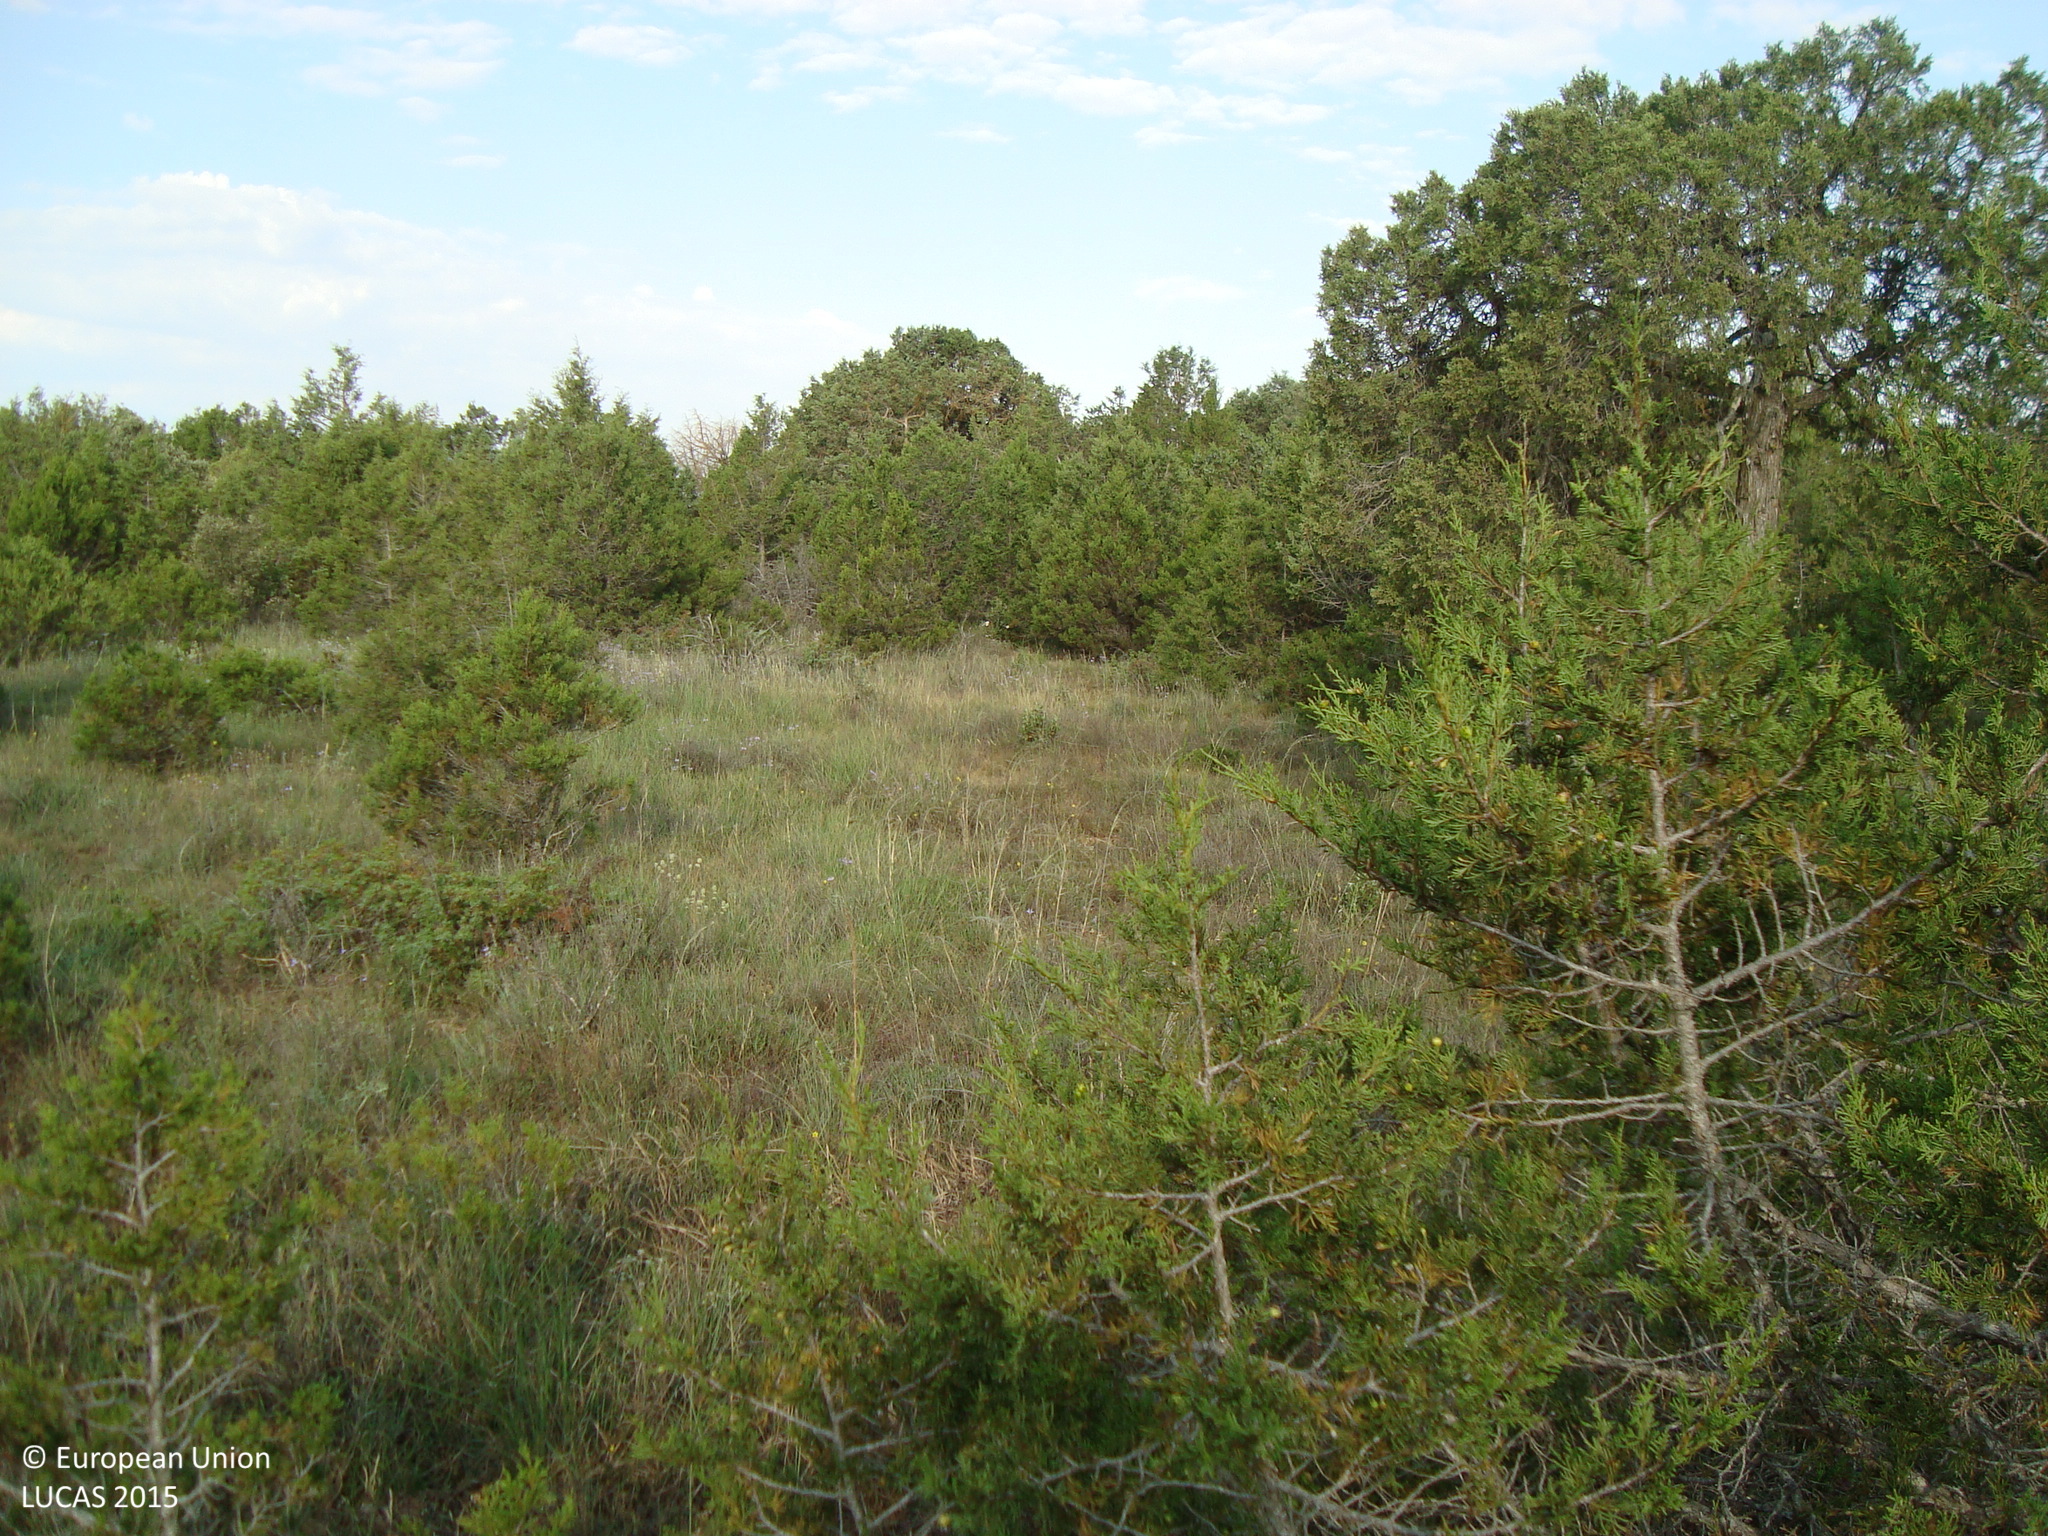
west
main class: Woodland
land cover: Other coniferous woodland
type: coniferous forest of the mediterranean region
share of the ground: 25 - 50 %
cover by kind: coniferous forest trees 40 %, shrubs 40 %, herbaceous plants 10 %, unconsolidated bare surface 10 %
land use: Forestry
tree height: > 5 m
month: June
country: ES
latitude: 41.9394
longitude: -3.8198
